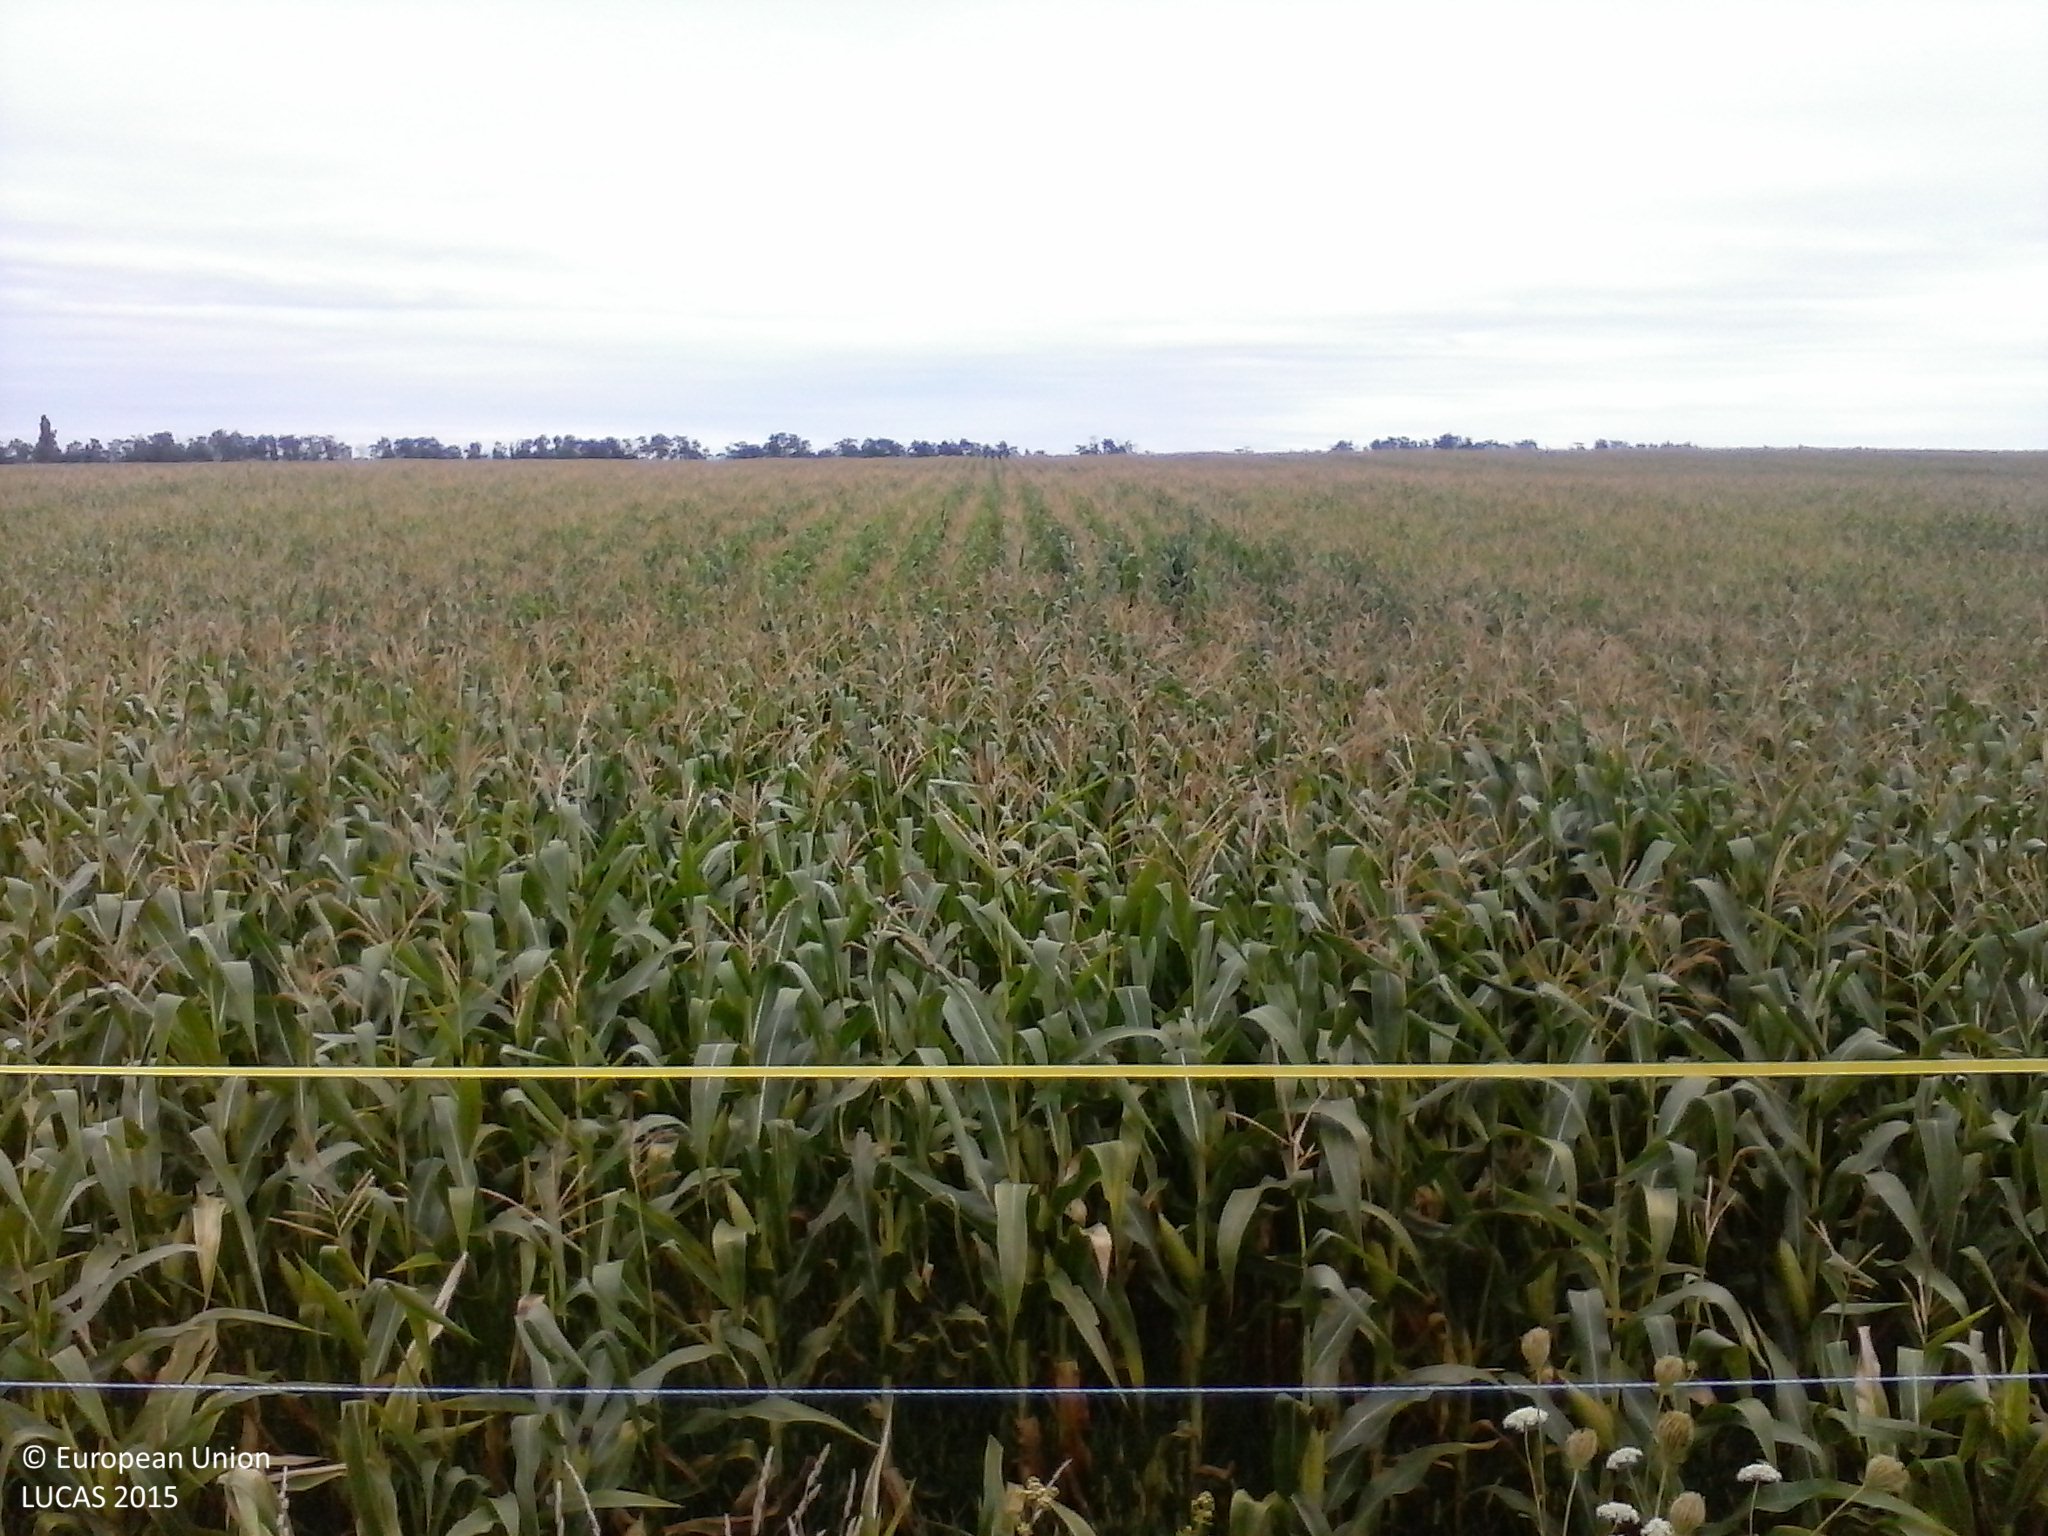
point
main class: Cropland
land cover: Maize
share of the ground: > 75 %
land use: Agriculture (excluding fallow land and kitchen gardens)
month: July
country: HU
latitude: 46.1131
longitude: 17.6512
